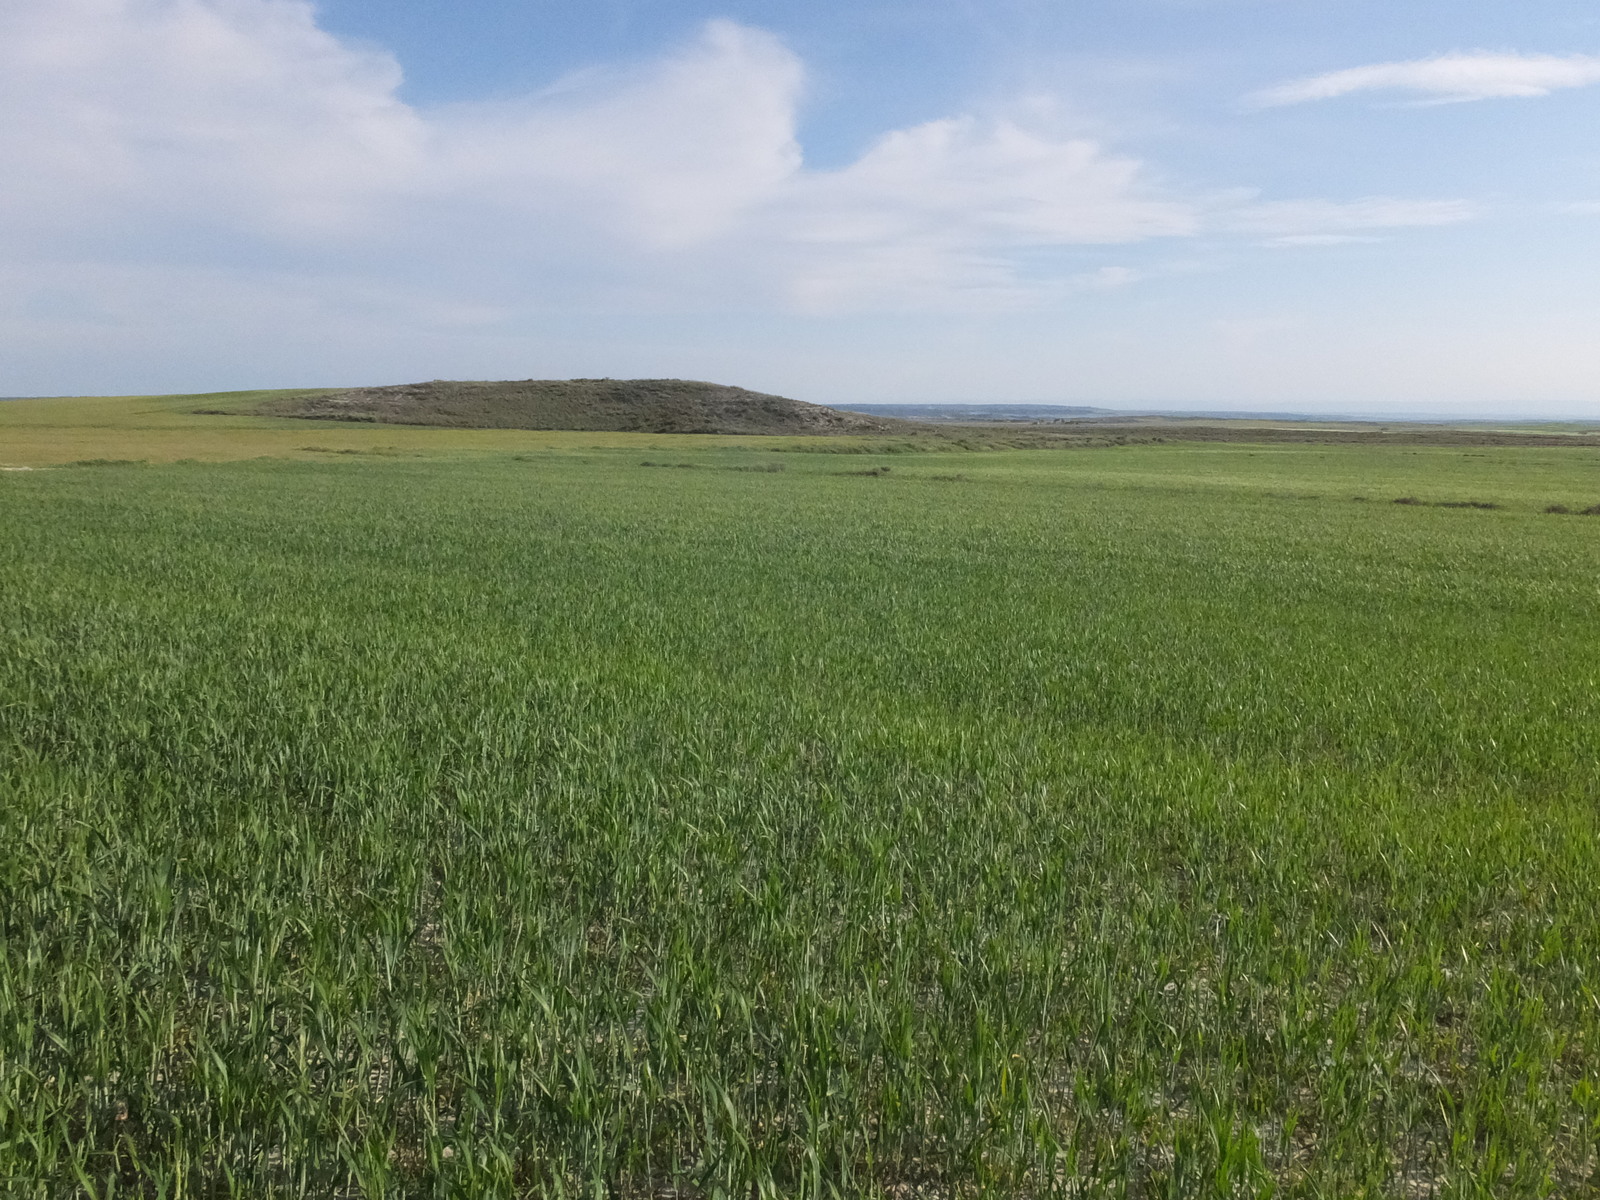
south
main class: Cropland
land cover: Common wheat
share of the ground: > 75 %
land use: Agriculture (excluding fallow land and kitchen gardens)
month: April
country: ES
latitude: 41.5617
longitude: -0.3172
